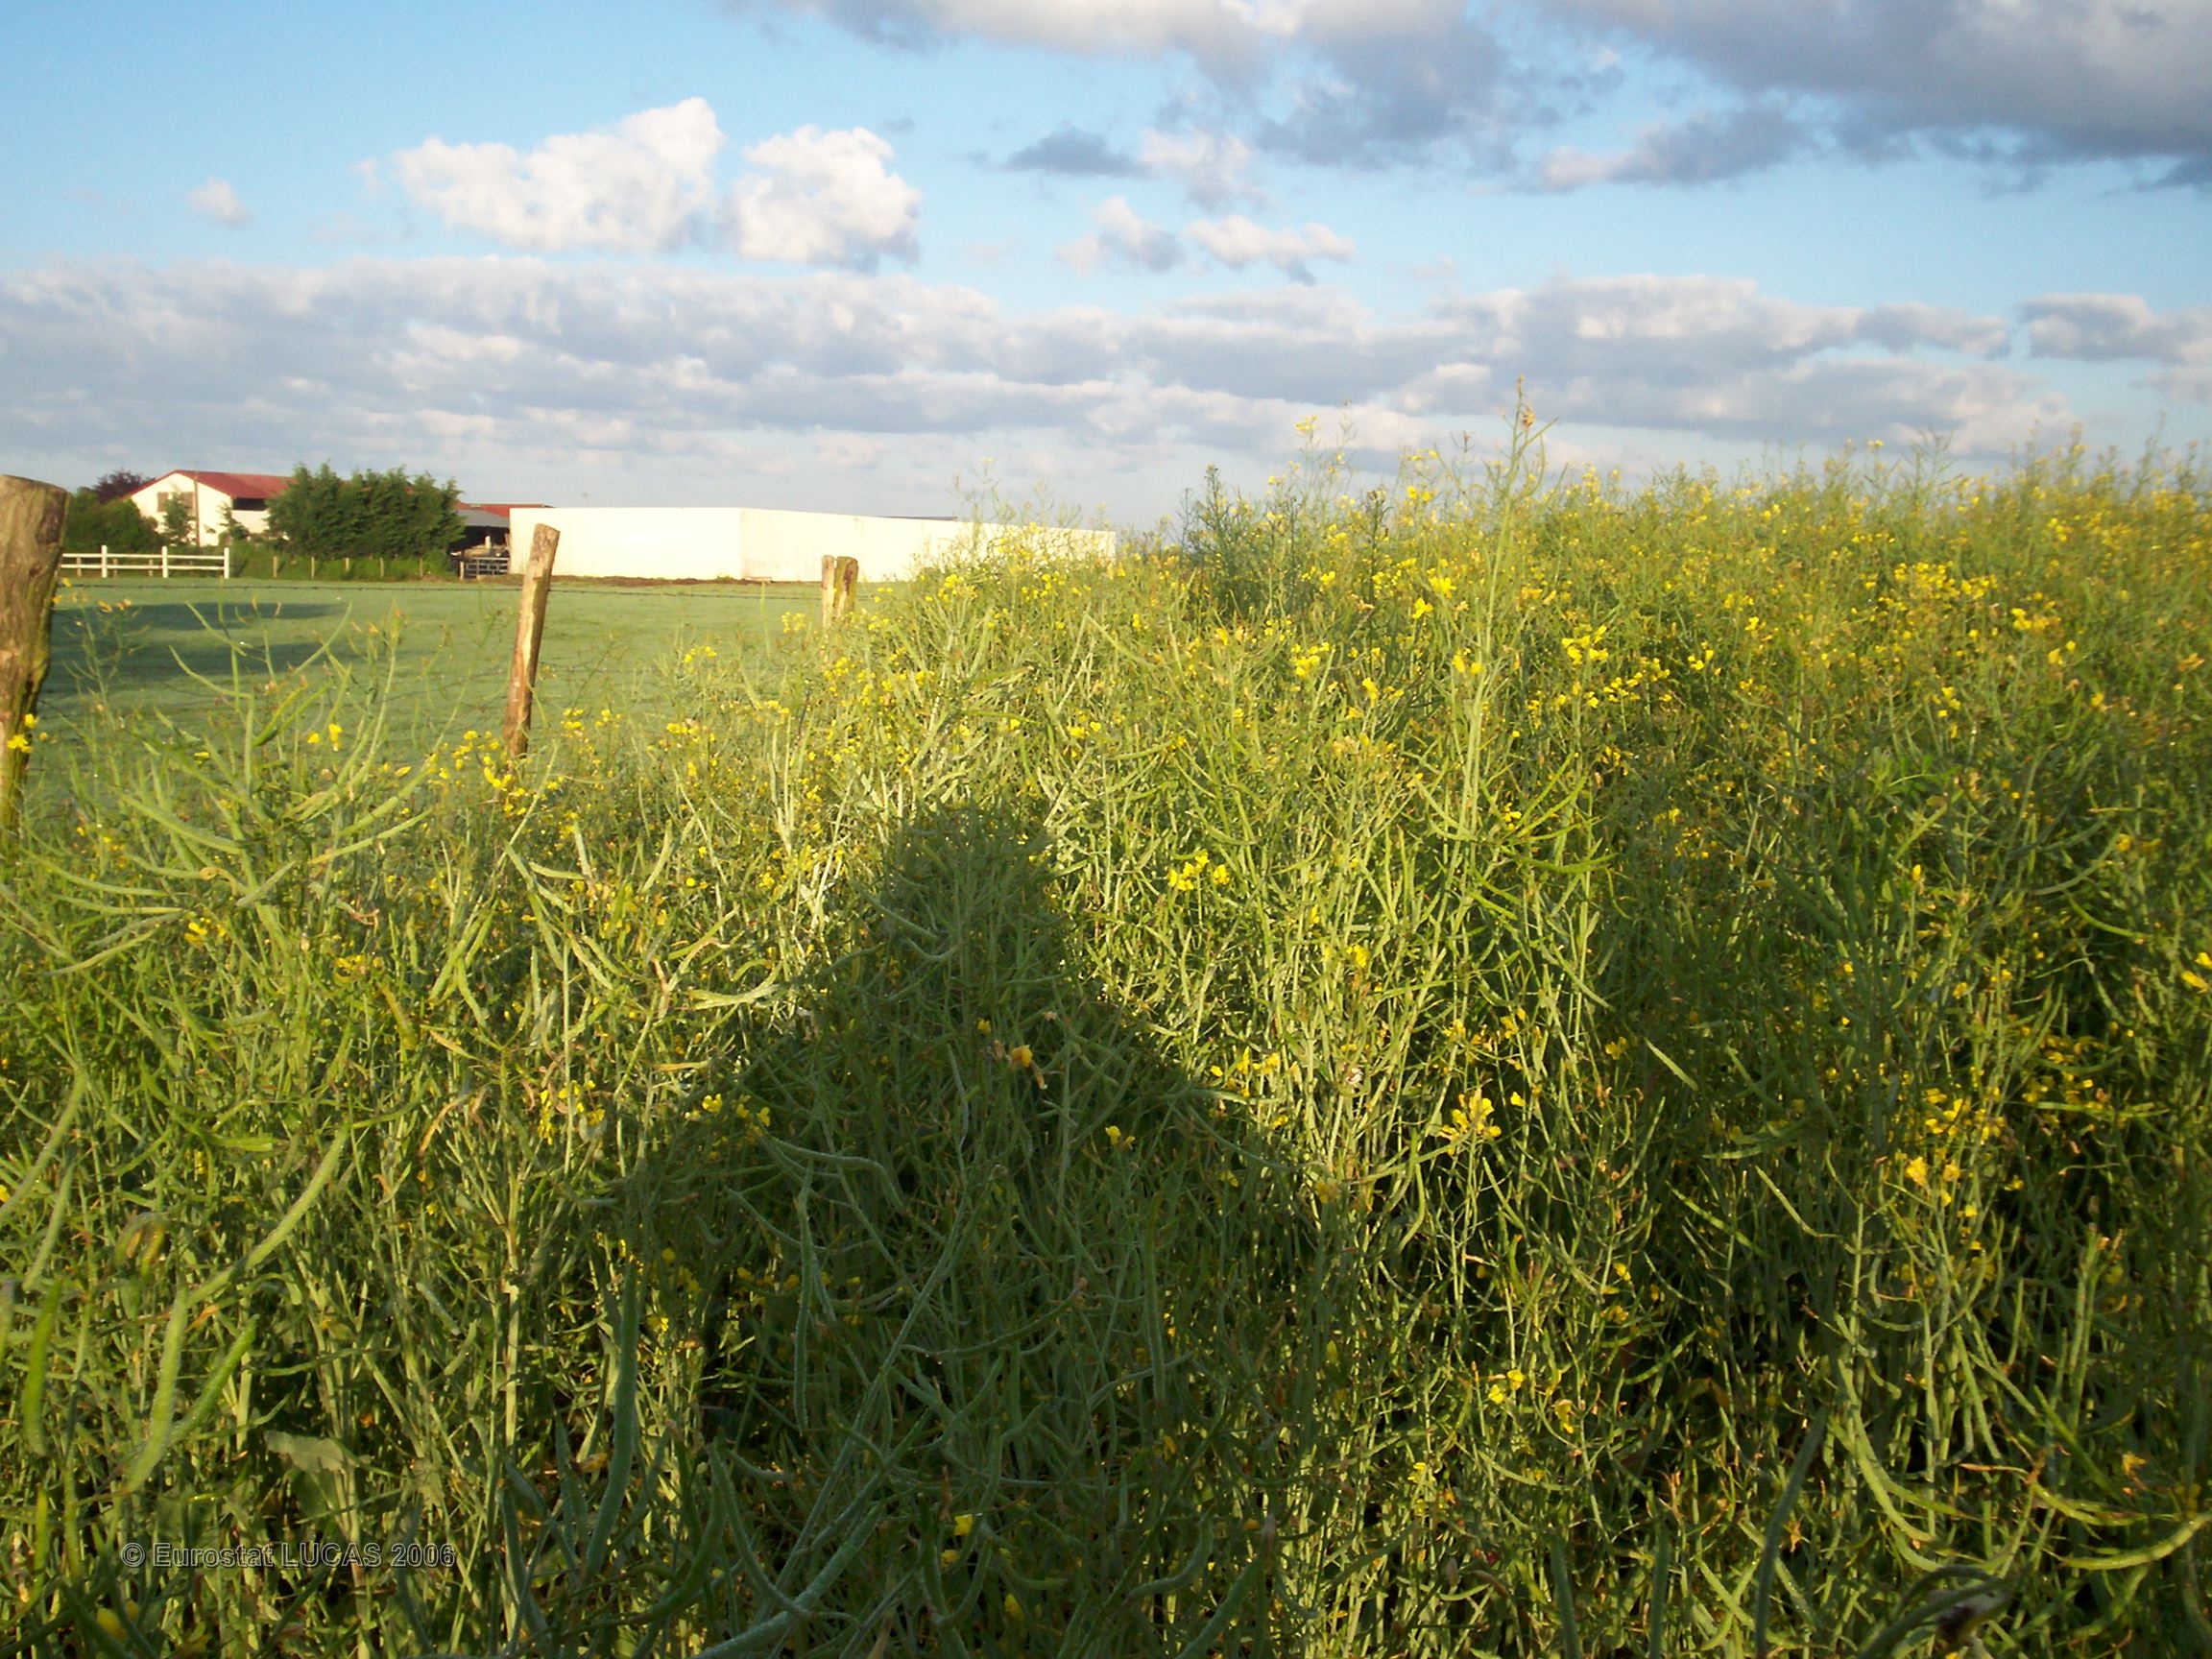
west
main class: Cropland
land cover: Rape and turnip rape
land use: Agriculture (excluding fallow land and kitchen gardens)
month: May
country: FR
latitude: 47.0799
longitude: 5.3521
